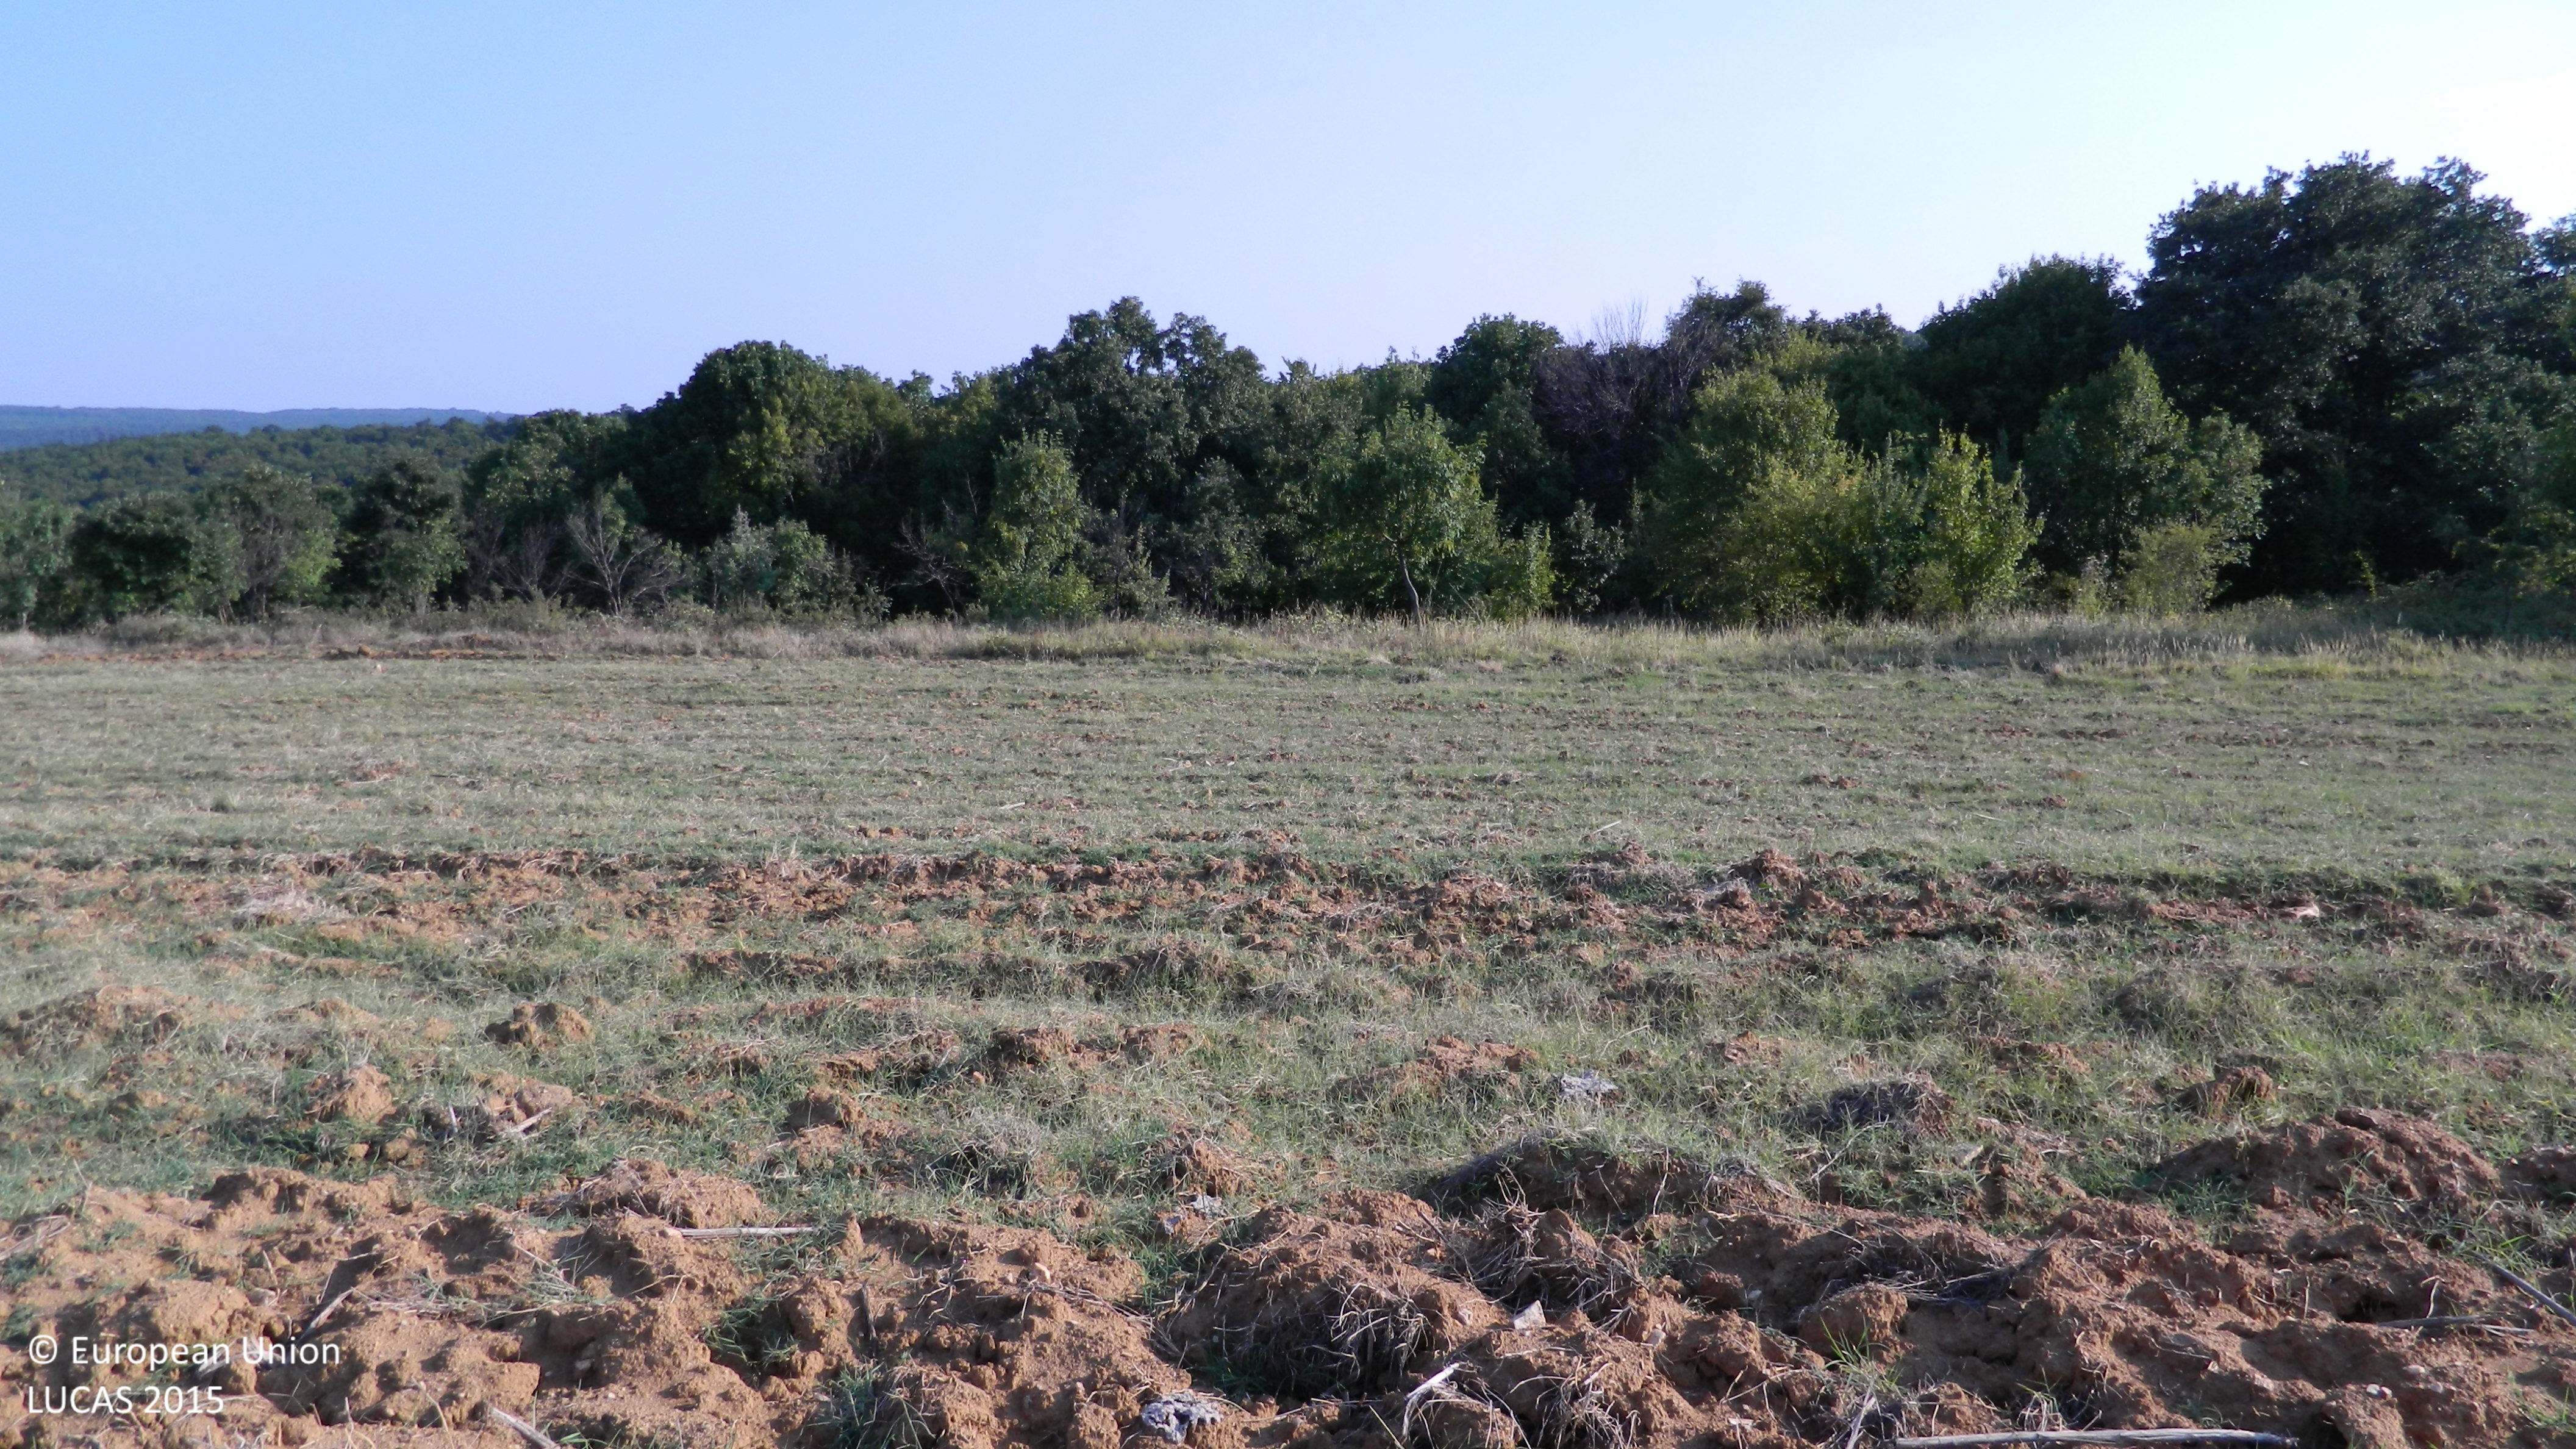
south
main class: Grassland
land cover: Spontaneously vegetated surfaces
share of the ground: 25 - 50 %
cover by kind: unconsolidated bare surface 70 %, herbaceous plants 30 %
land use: Agriculture (excluding fallow land and kitchen gardens)
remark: Harvested field
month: August
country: BG
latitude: 41.5167
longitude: 26.0171
